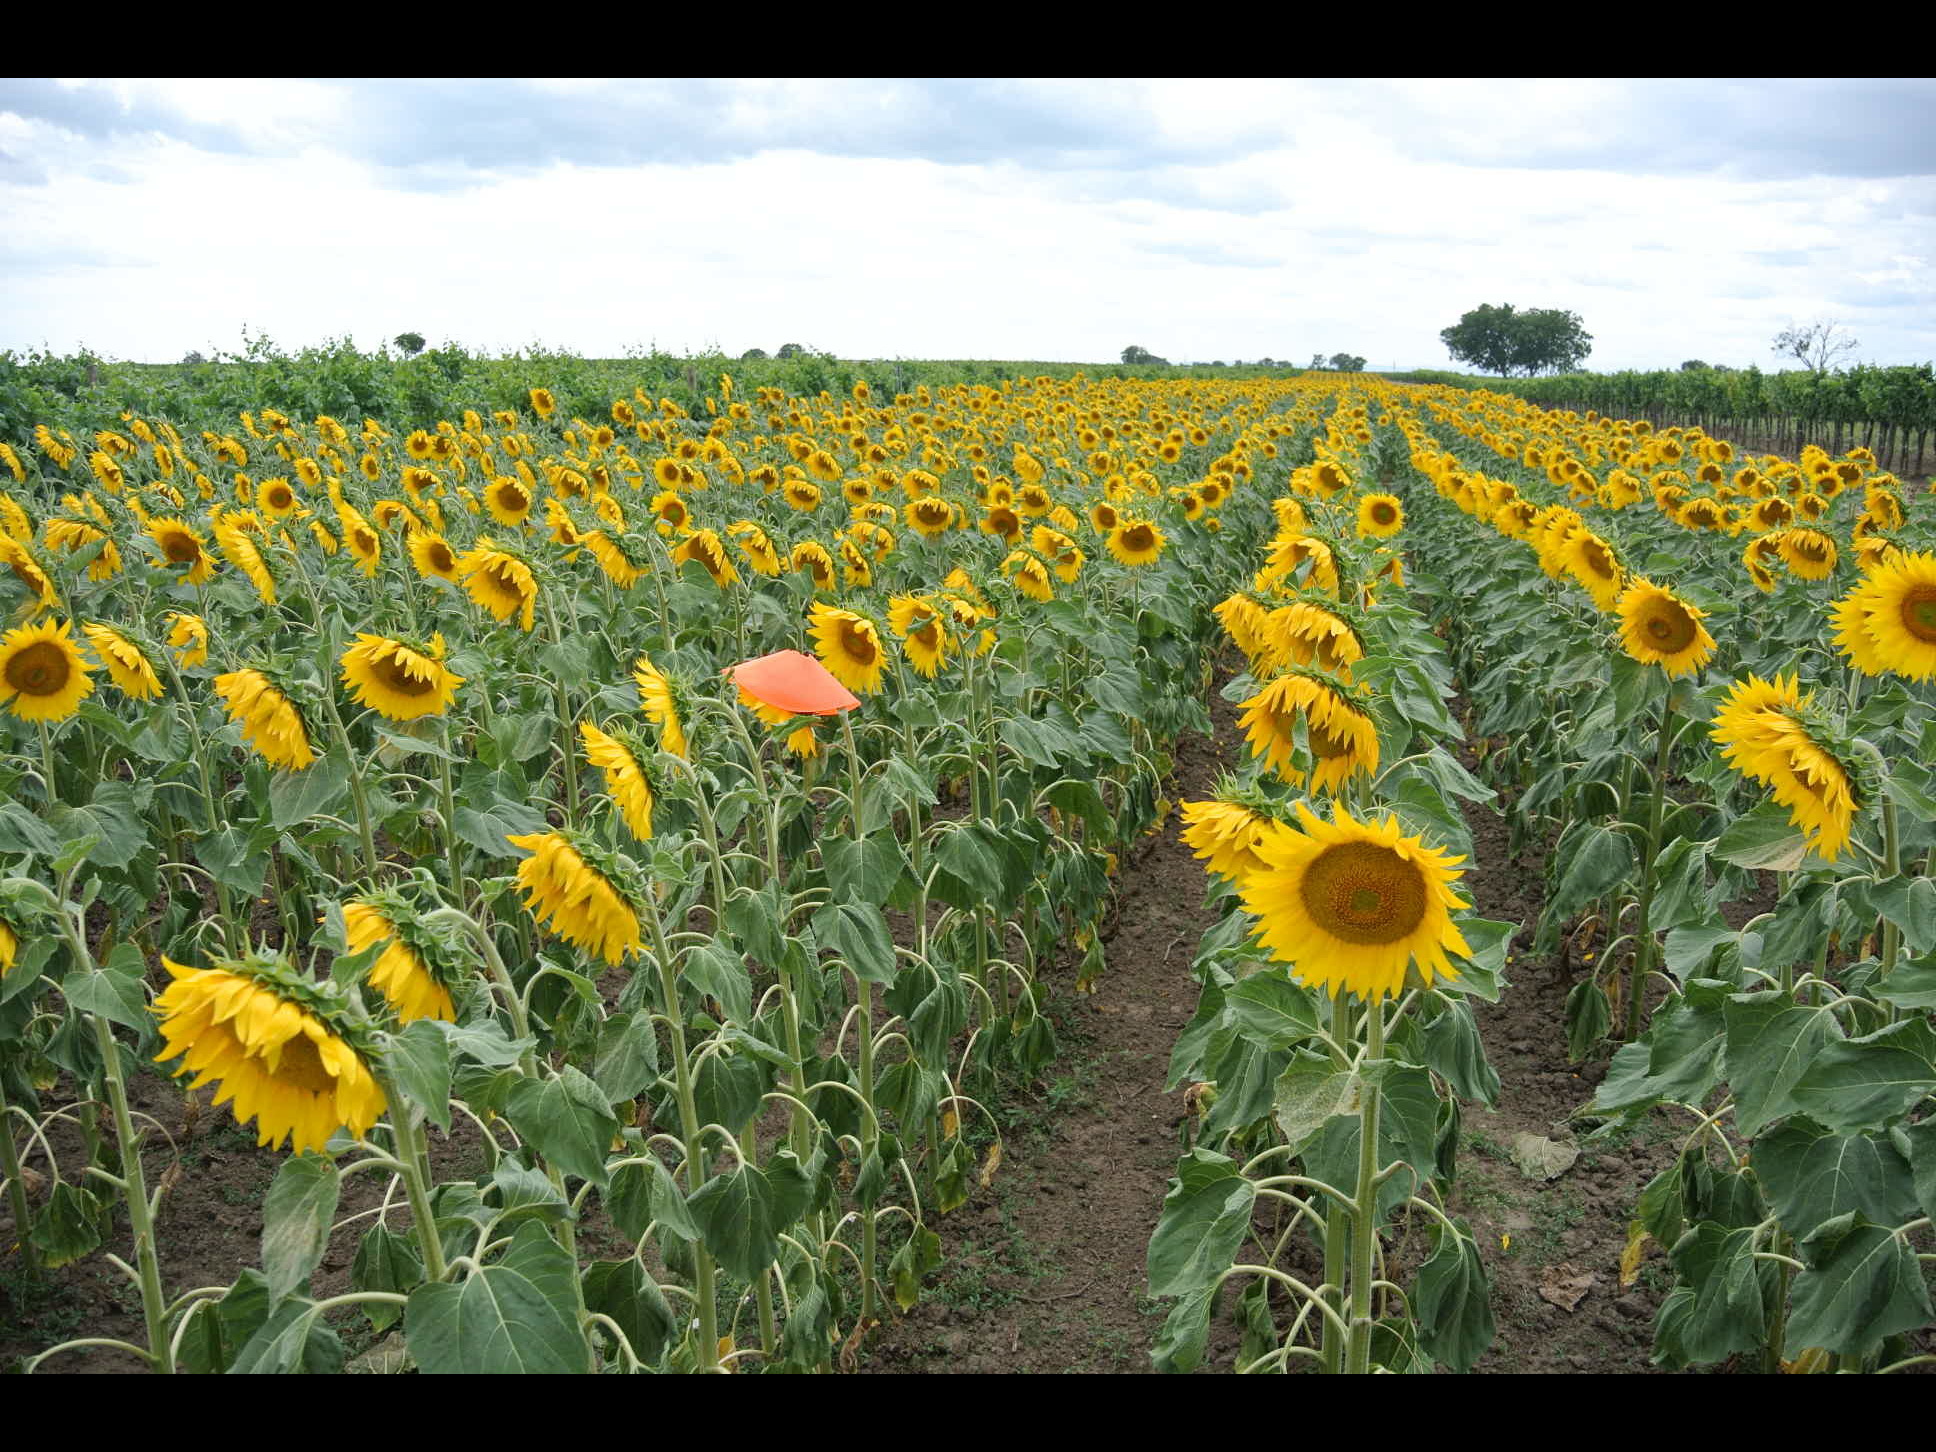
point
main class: Cropland
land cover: Sunflower
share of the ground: > 75 %
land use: Agriculture (excluding fallow land and kitchen gardens)
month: July
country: AT
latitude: 47.8617
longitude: 16.9171
